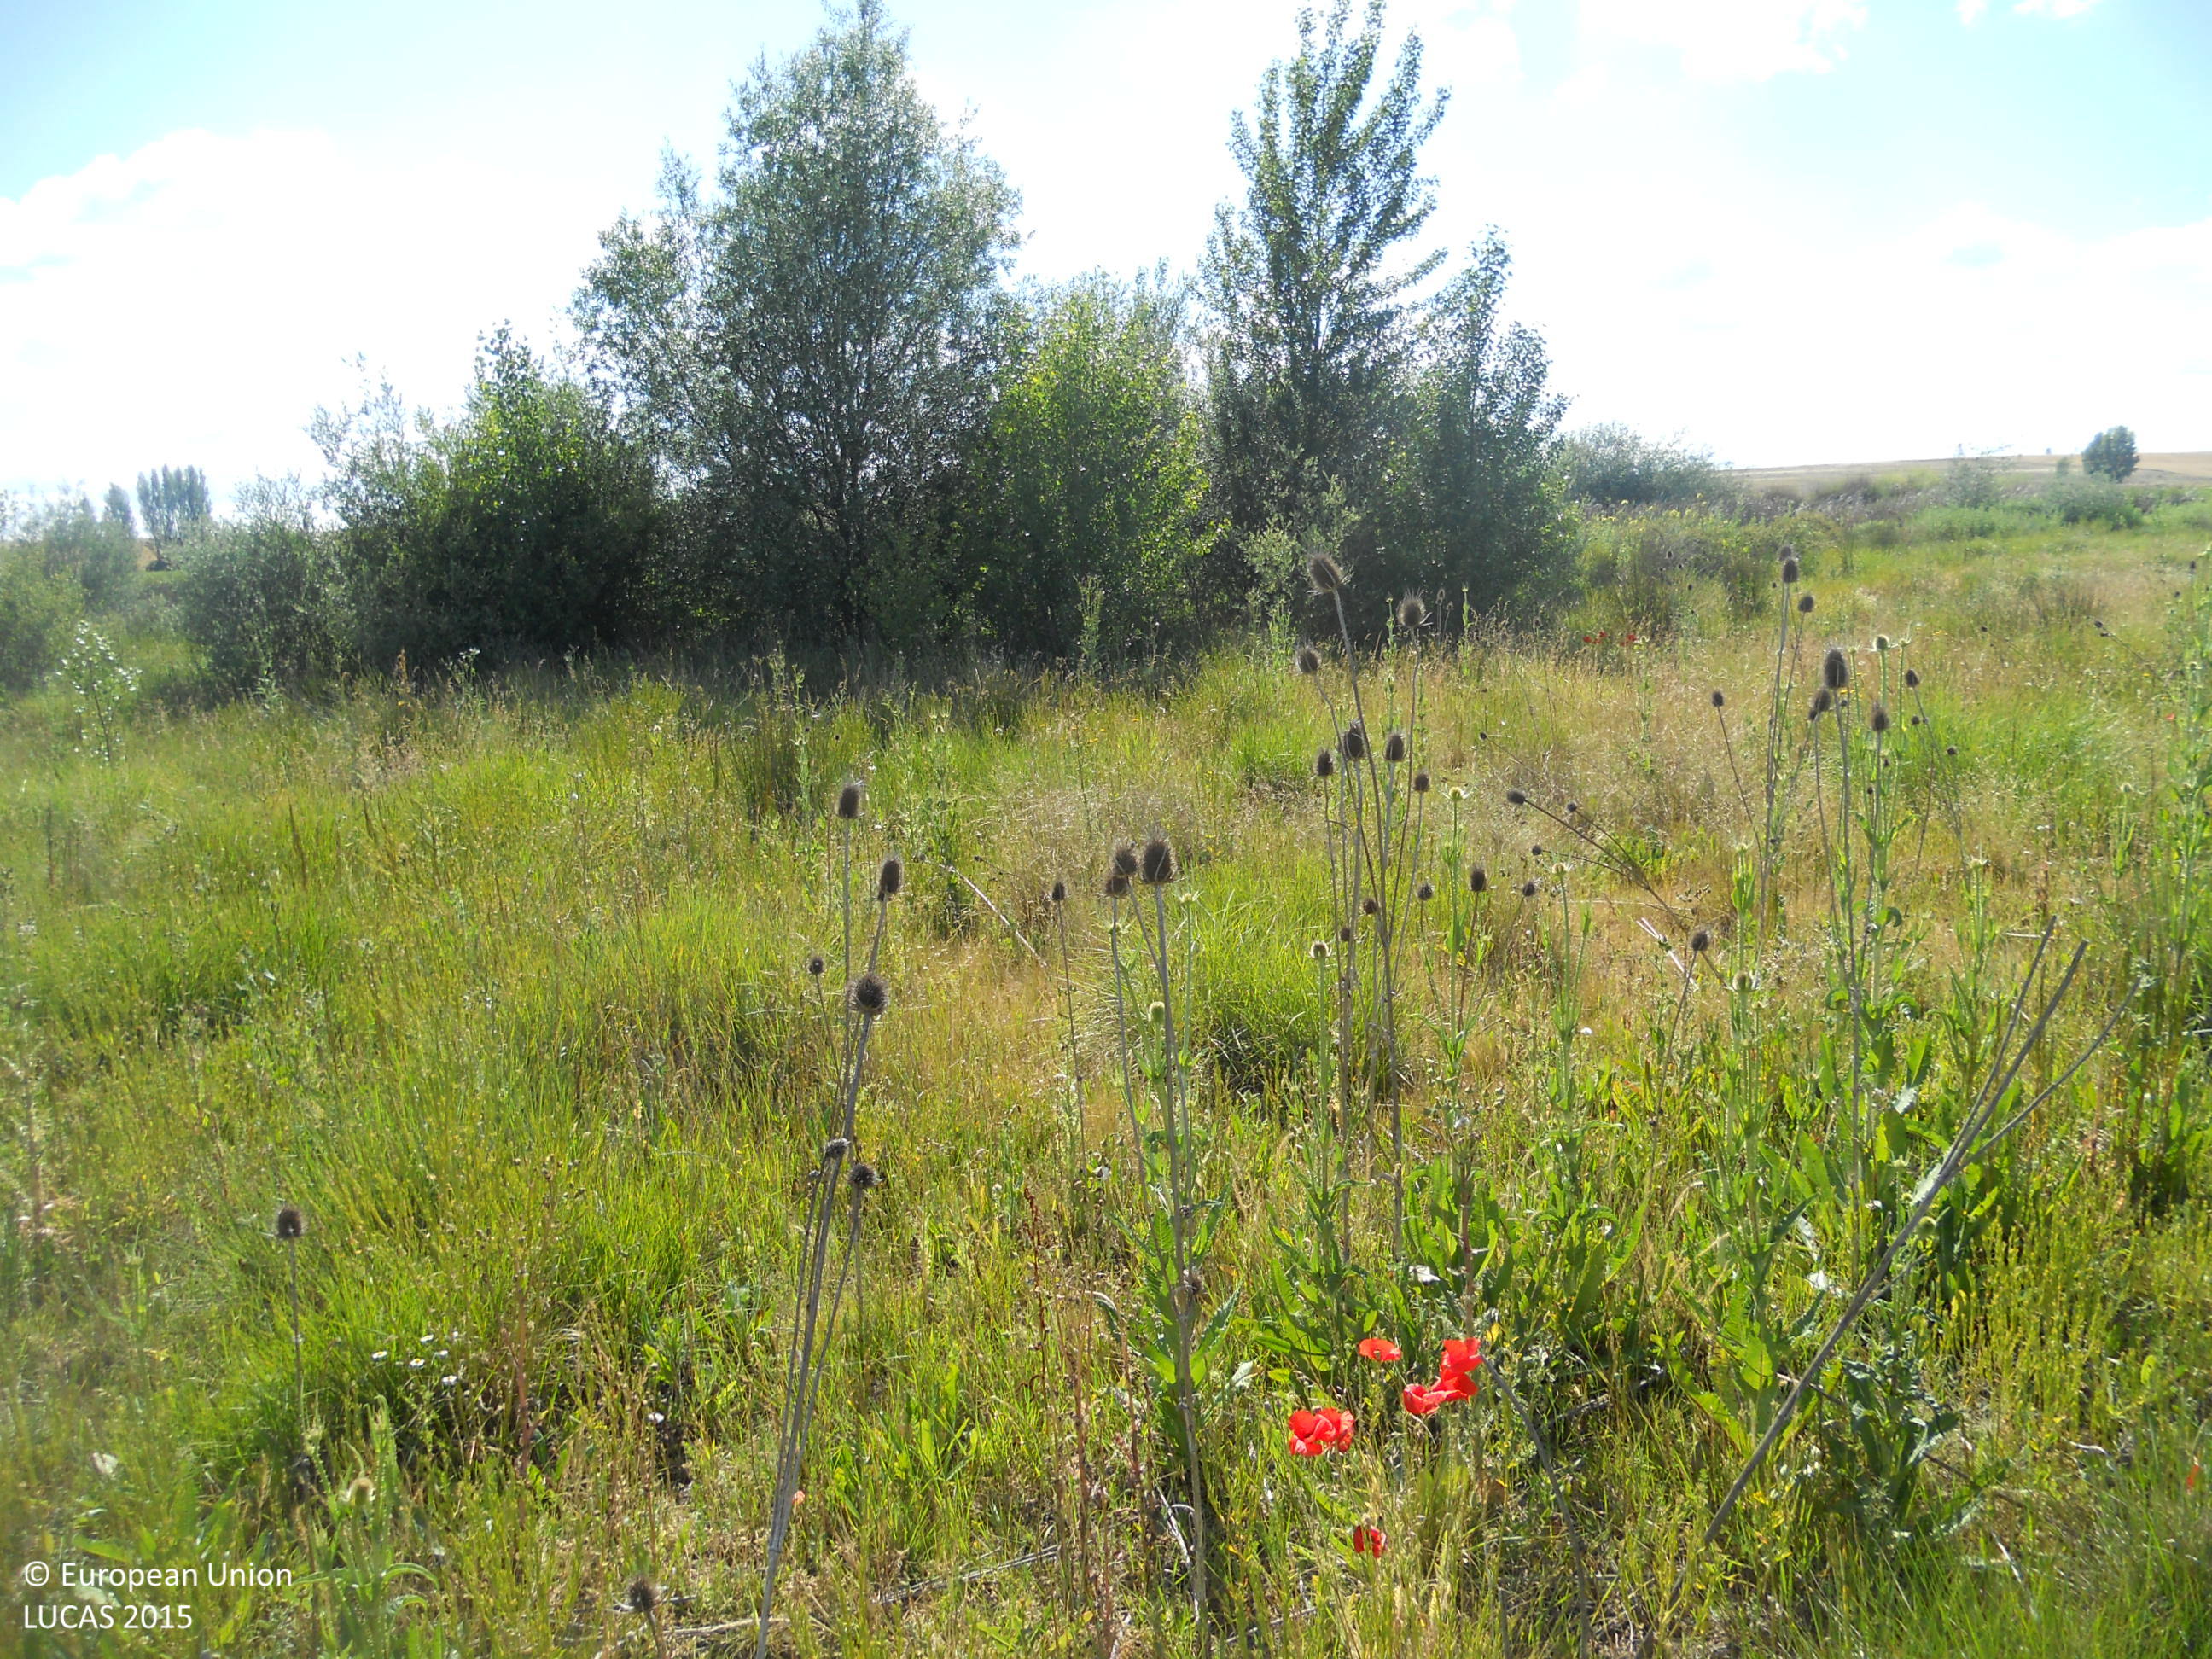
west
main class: Grassland
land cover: Grassland without tree/shrub cover
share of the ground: > 75 %
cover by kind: herbaceous plants 100 %
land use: Abandoned areas
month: June
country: ES
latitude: 42.2087
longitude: -5.2383
